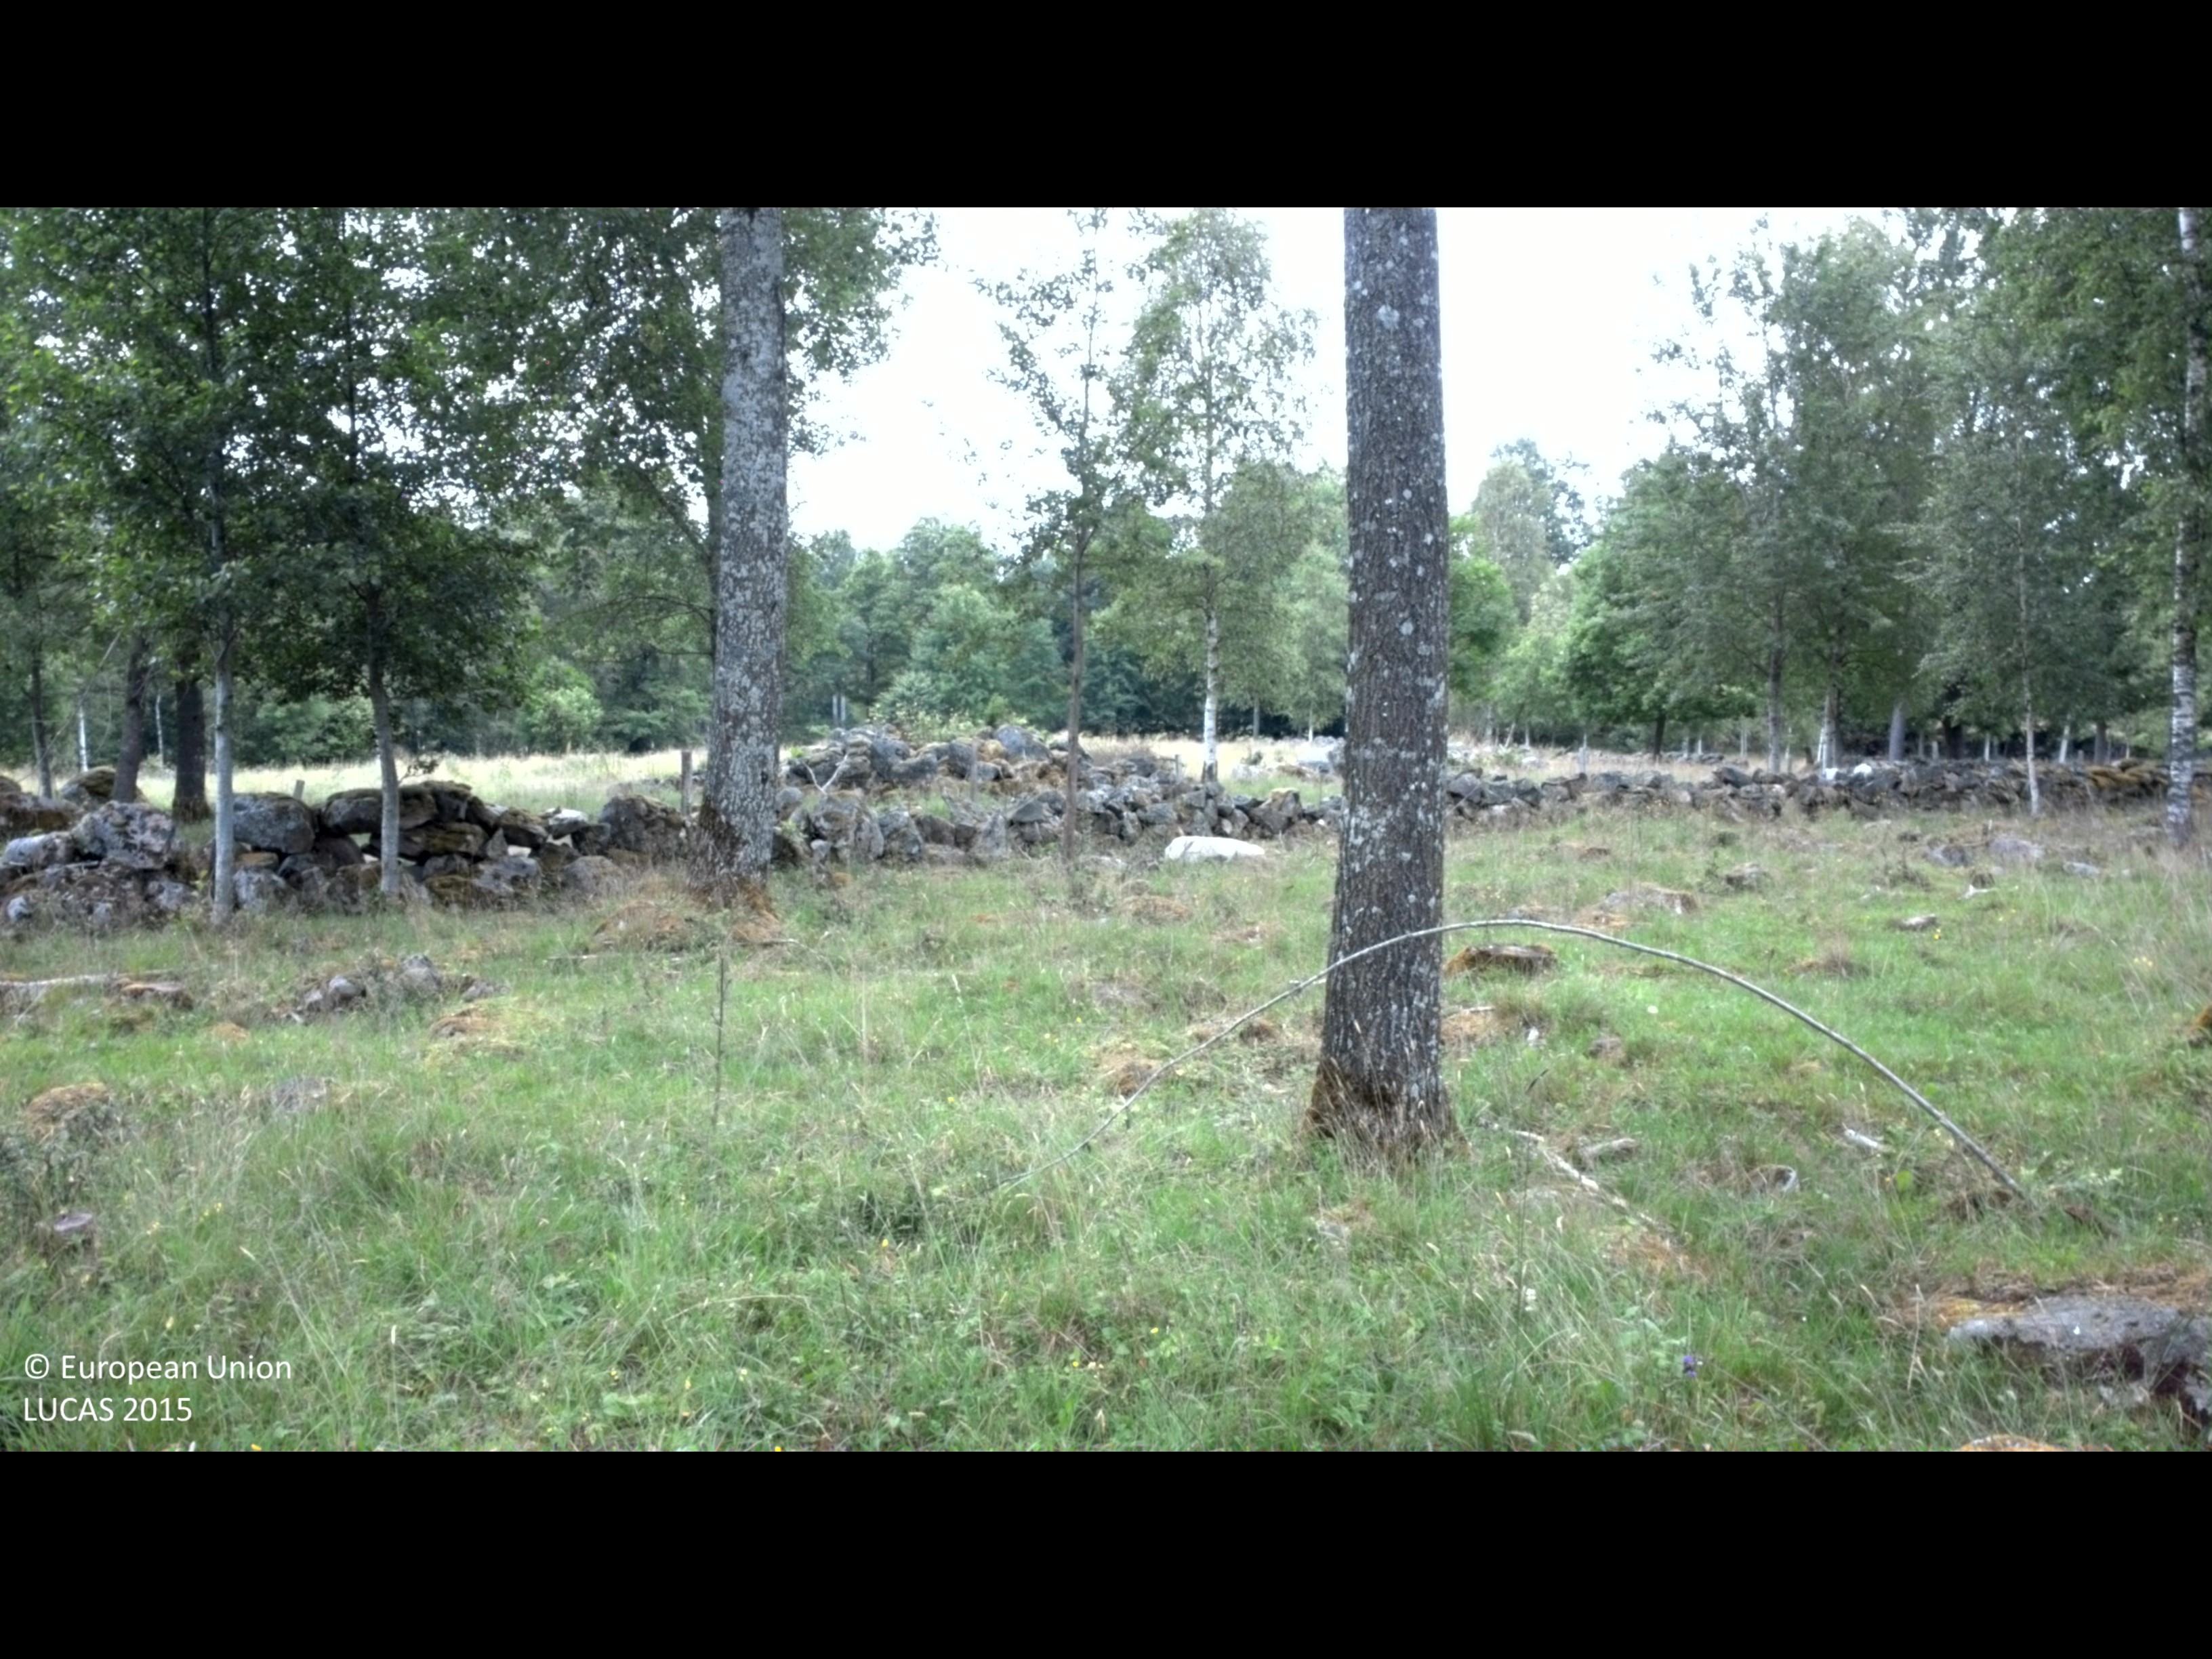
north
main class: Woodland
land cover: Broadleaved woodland
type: non-riverine alder, birch or aspen forest
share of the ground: 25 - 50 %
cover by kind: broadleaved forest trees 40 %, herbaceous plants 40 %, shrubs 10 %, consolidated bare surface 10 %
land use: Agriculture (excluding fallow land and kitchen gardens)
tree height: > 5 m
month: July
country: SE
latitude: 56.4895
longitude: 14.4312
